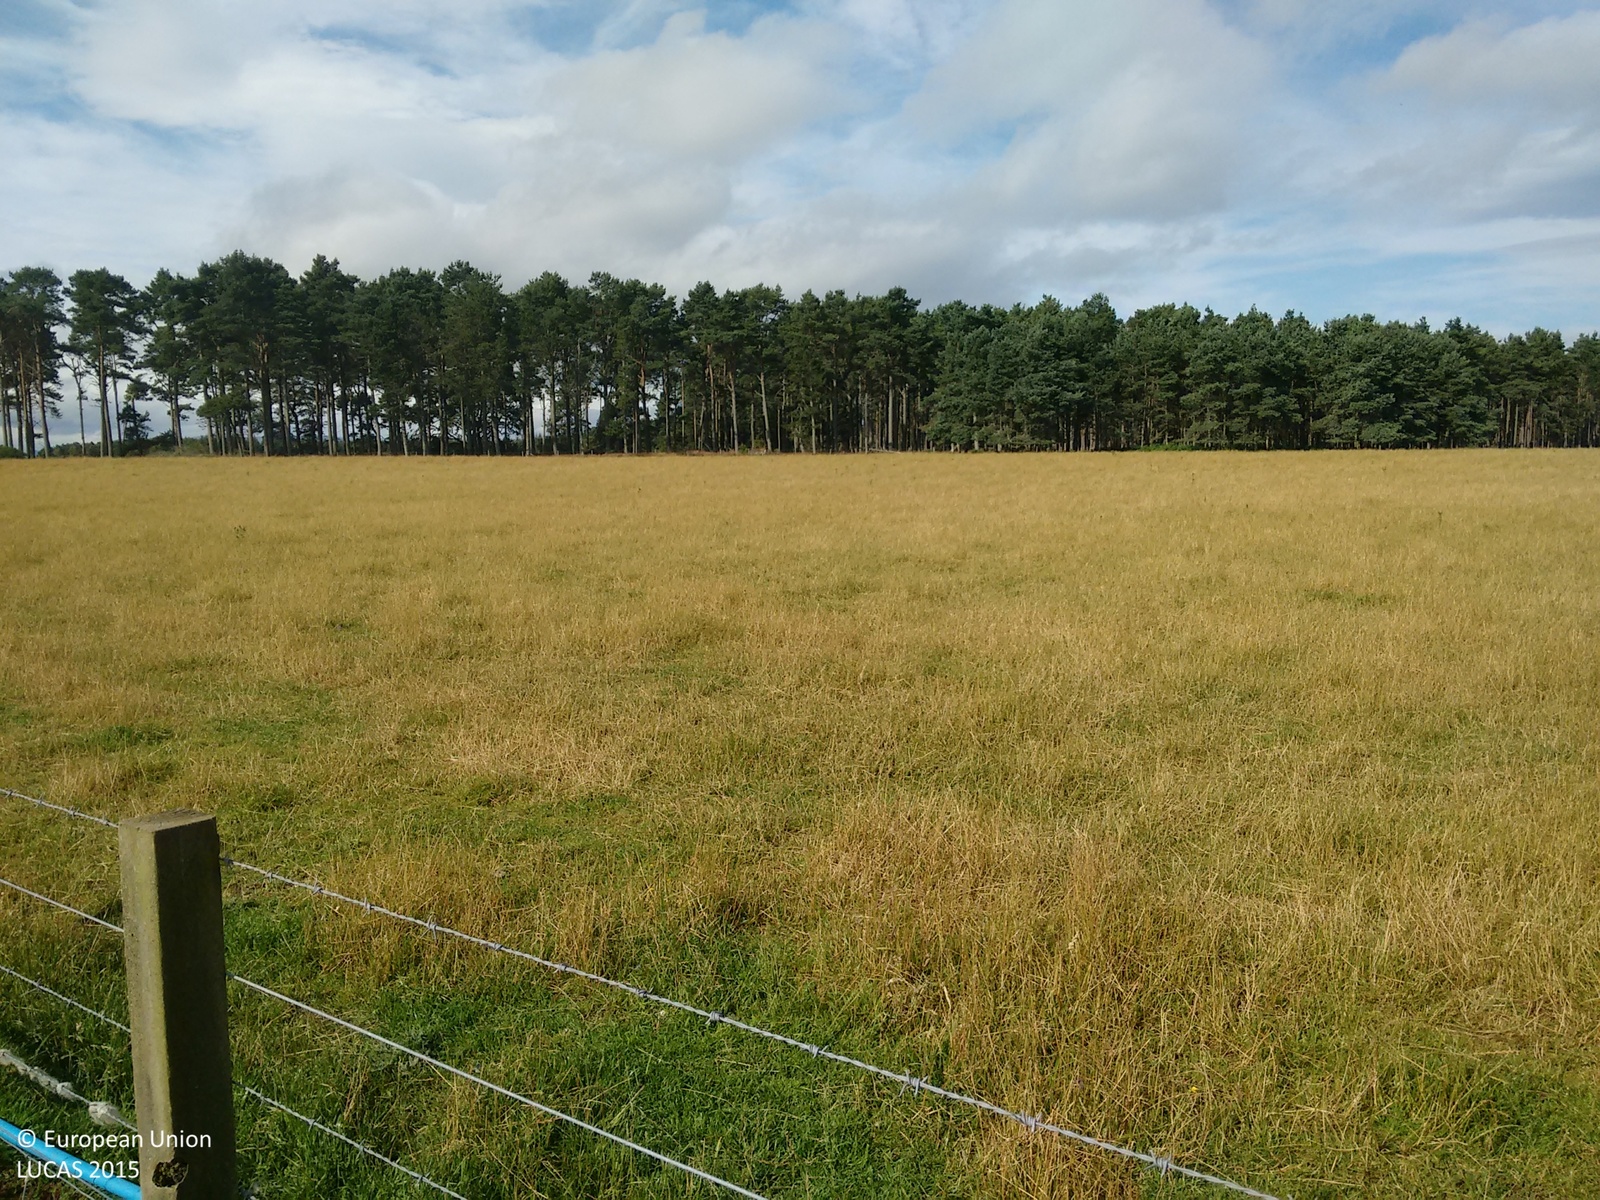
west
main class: Grassland
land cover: Spontaneously vegetated surfaces
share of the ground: 50 - 75 %
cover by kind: herbaceous plants 75 %, unconsolidated bare surface 25 %
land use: Agriculture (excluding fallow land and kitchen gardens)
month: August
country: GB
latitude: 57.8781
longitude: -4.0580
